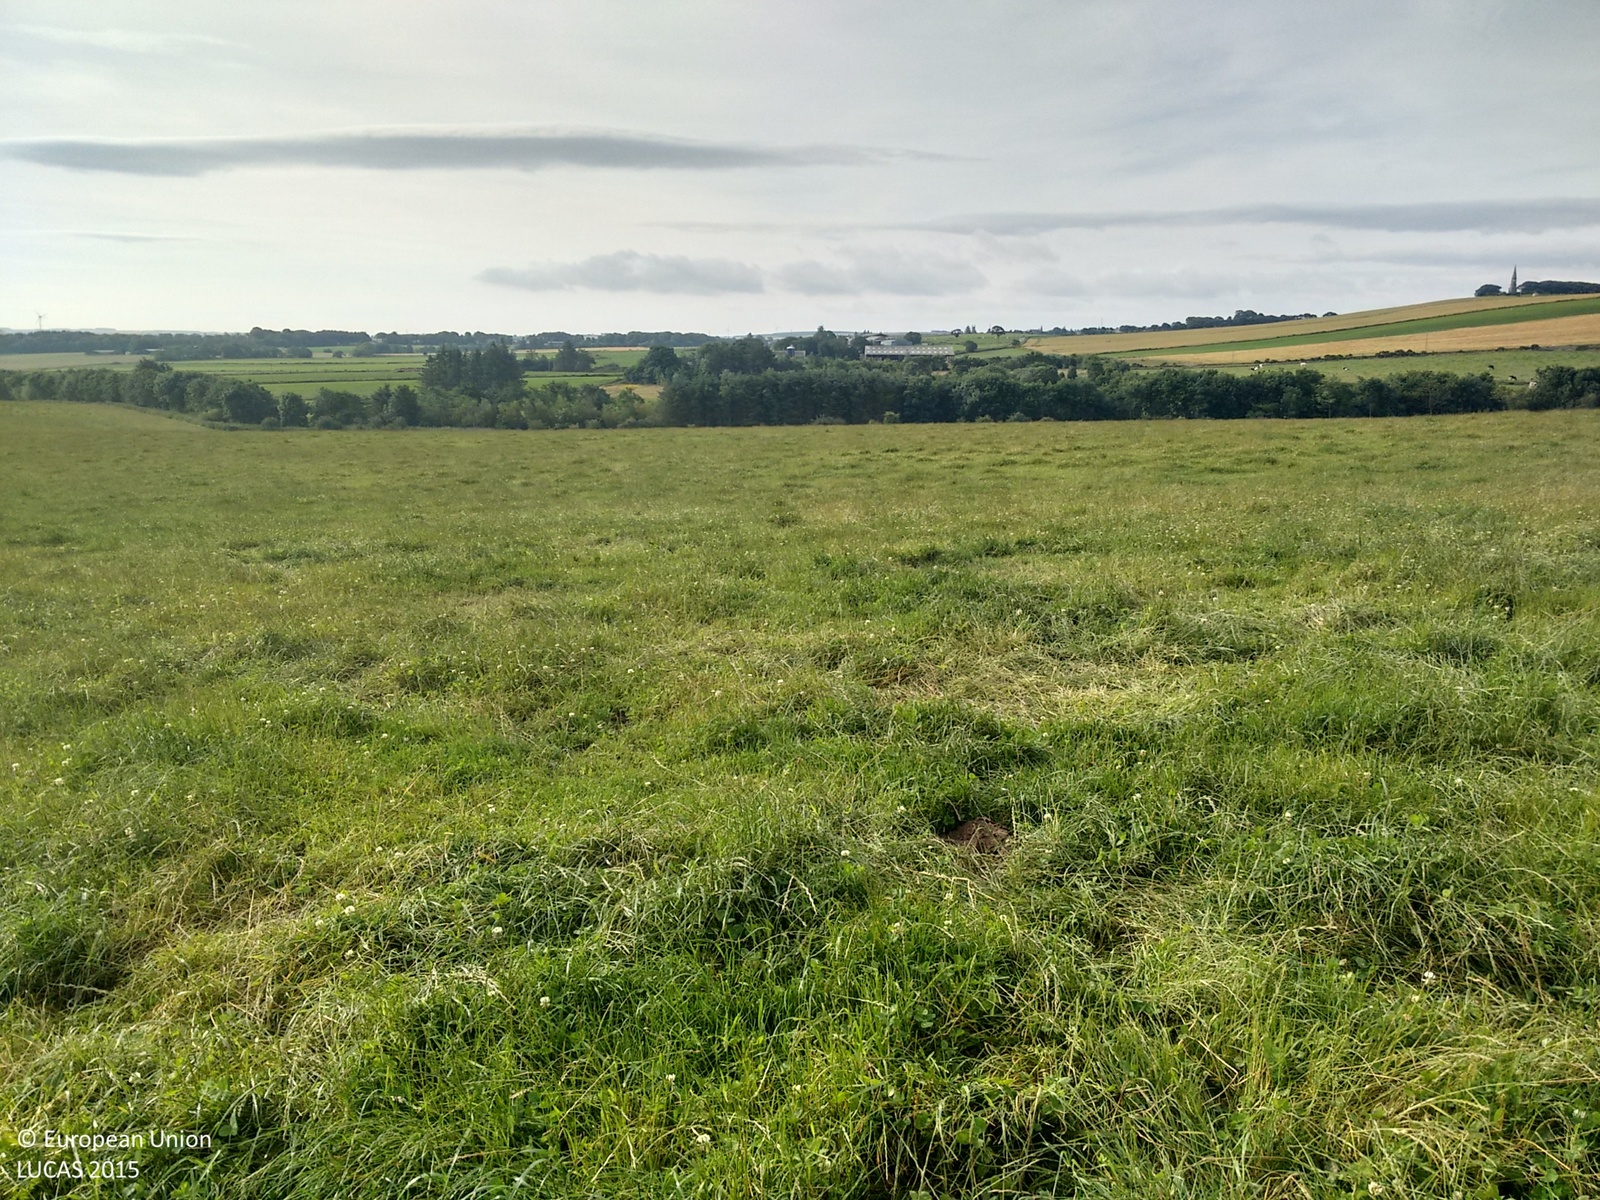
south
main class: Grassland
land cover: Grassland without tree/shrub cover
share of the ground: > 75 %
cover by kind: herbaceous plants 100 %
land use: Agriculture (excluding fallow land and kitchen gardens)
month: August
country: GB
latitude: 57.5345
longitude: -2.1908
